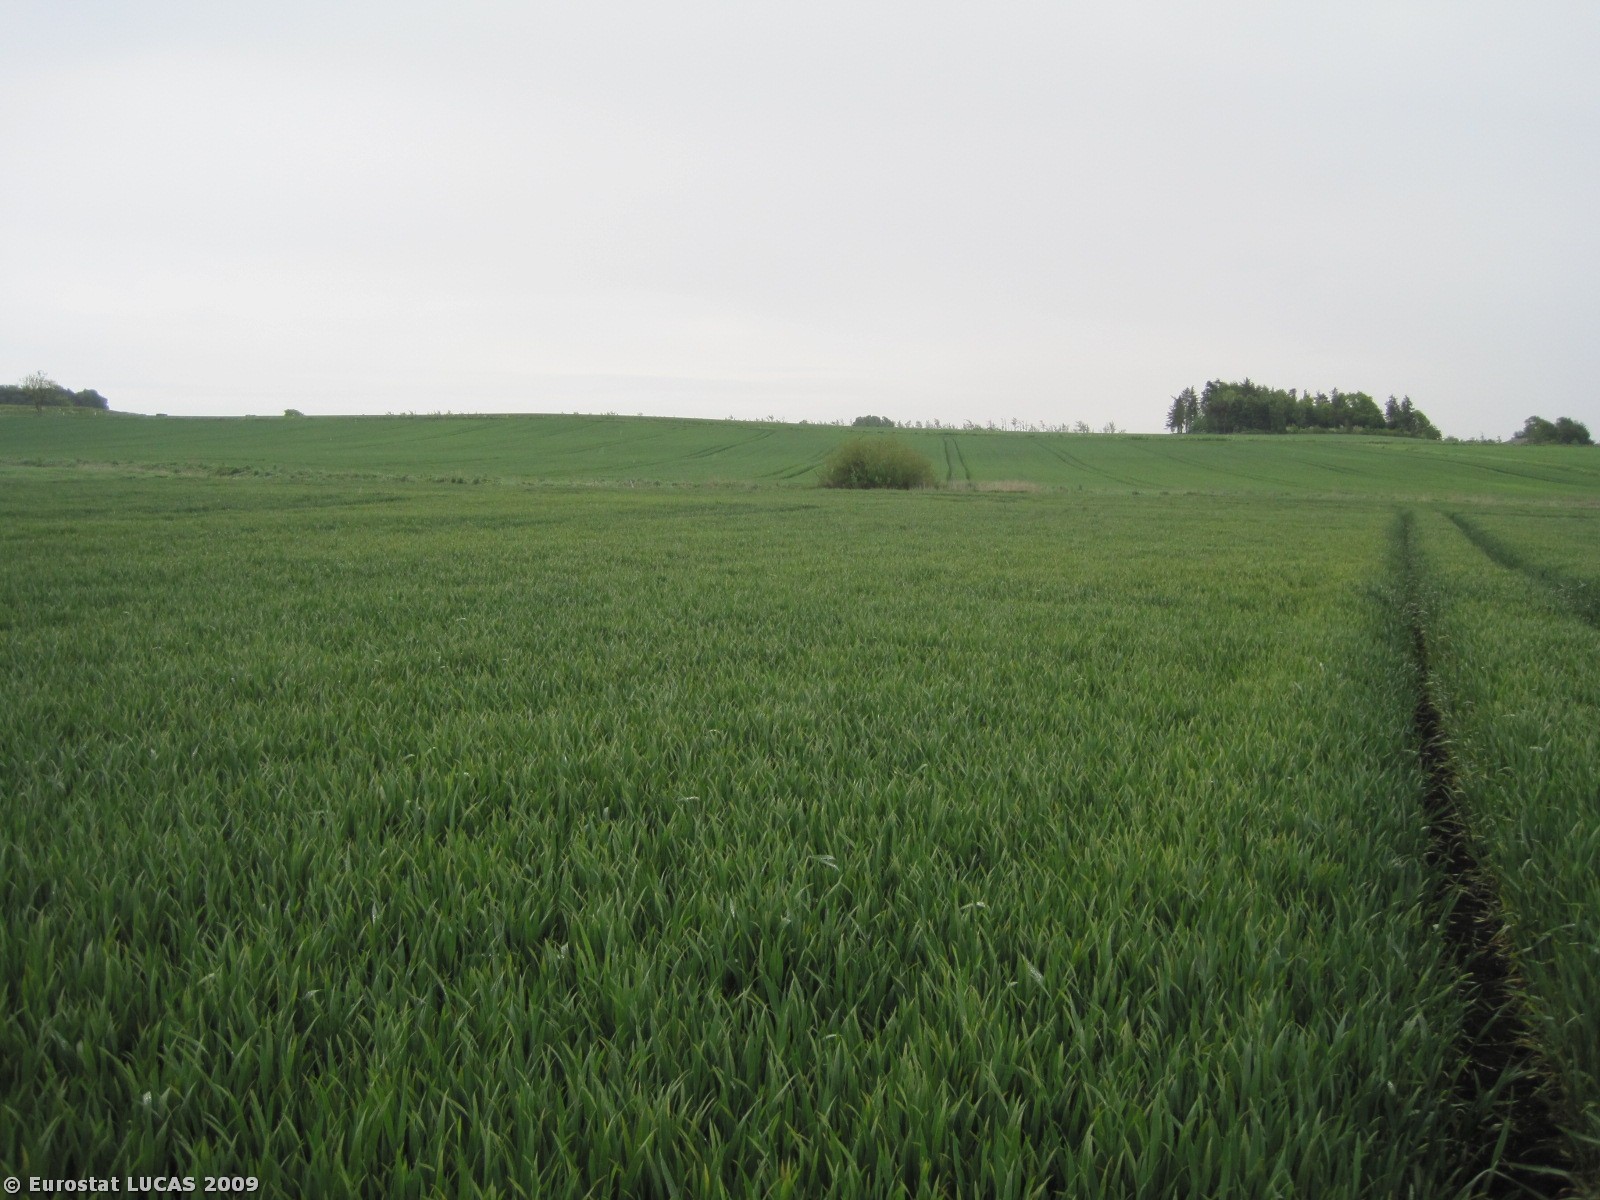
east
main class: Cropland
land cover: Common wheat
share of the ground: > 75 %
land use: Agriculture (excluding fallow land and kitchen gardens)
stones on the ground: < 10 %
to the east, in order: Common wheat; Grassland without tree/shrub cover; Ditches and canals; Grassland without tree/shrub cover; Common wheat
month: May
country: DK
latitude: 56.7629
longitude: 10.1470
